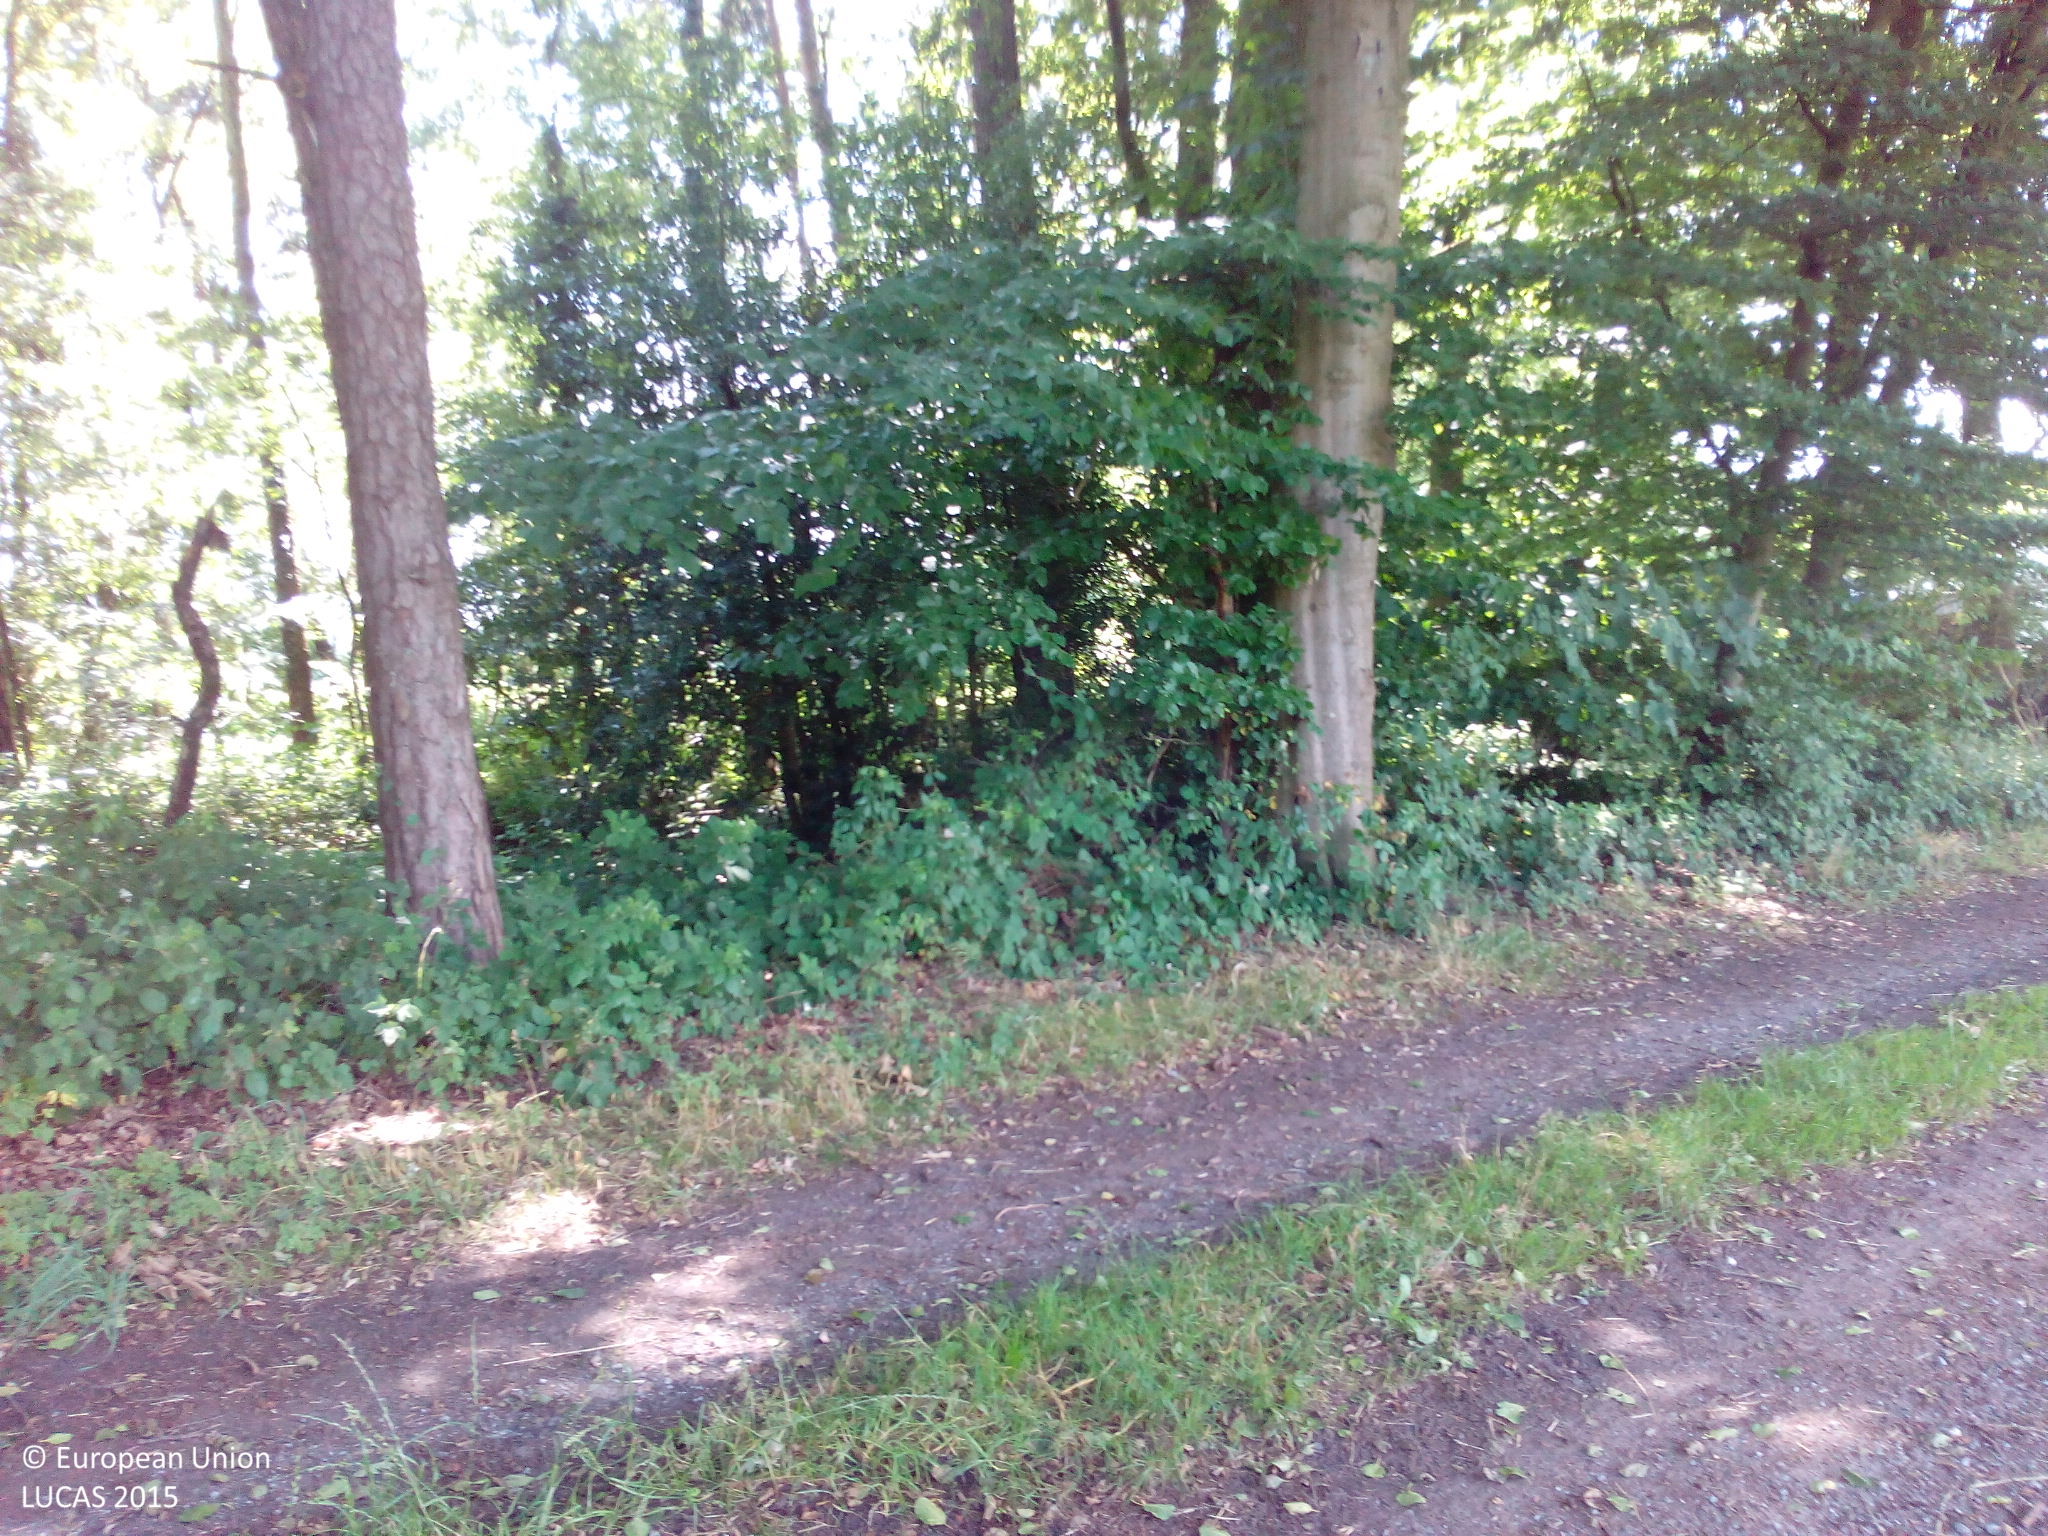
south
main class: Grassland
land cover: Grassland without tree/shrub cover
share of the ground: > 75 %
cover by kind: herbaceous plants 100 %
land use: Agriculture (excluding fallow land and kitchen gardens)
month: July
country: DE
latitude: 51.8460
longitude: 8.4472
